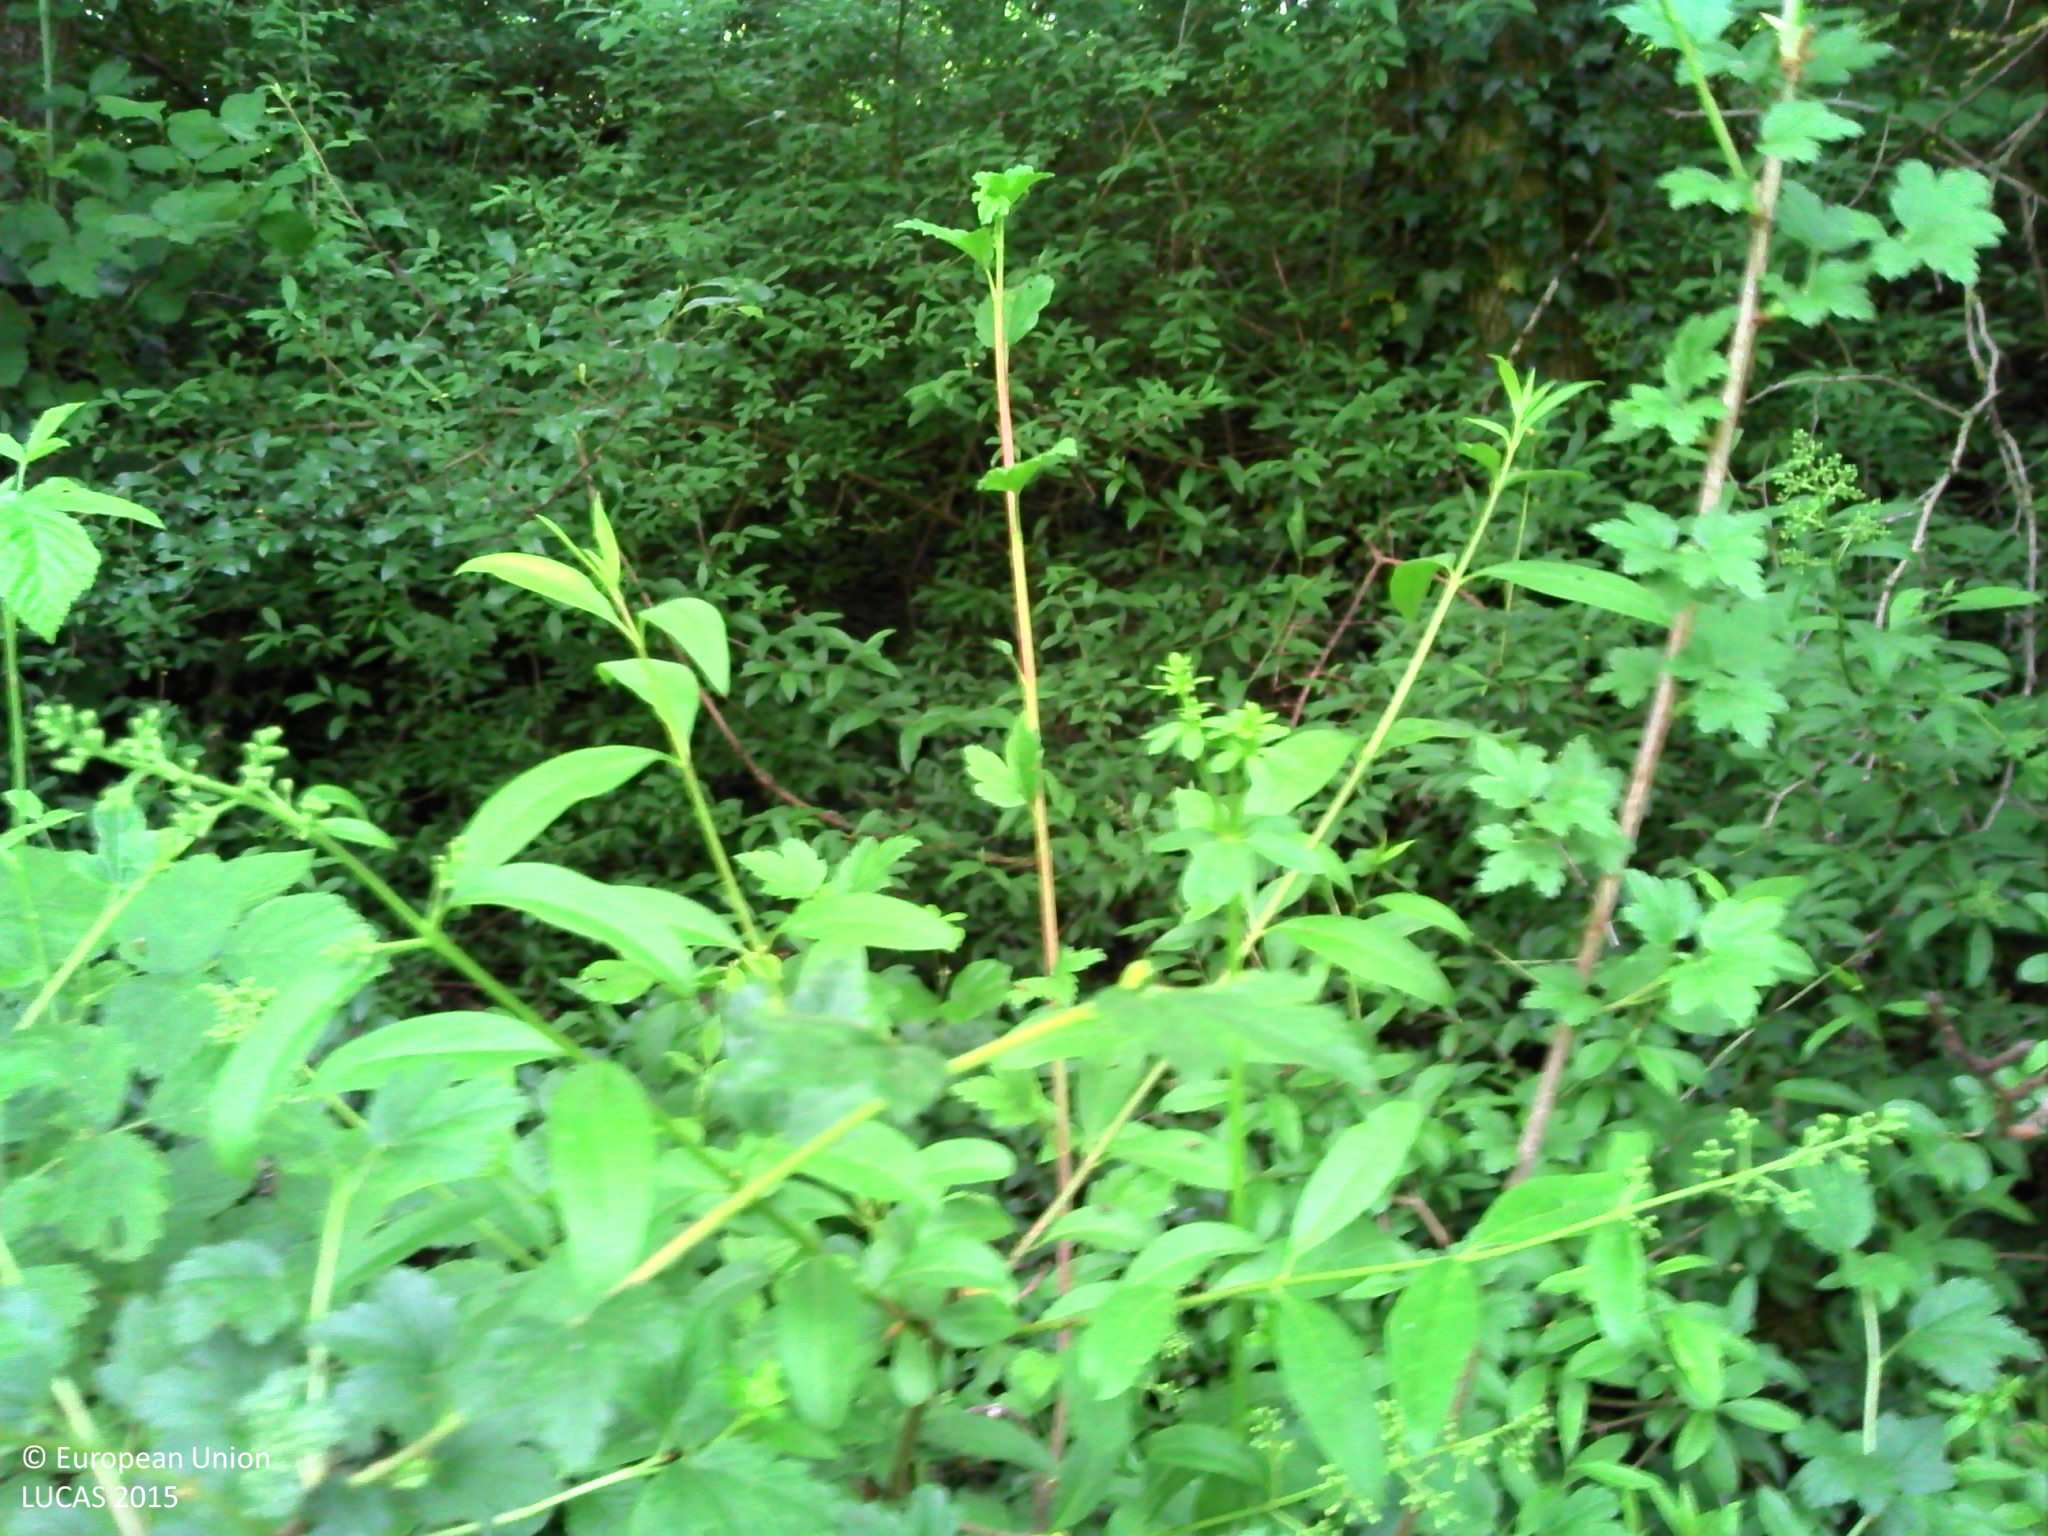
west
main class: Woodland
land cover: Broadleaved woodland
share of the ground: > 75 %
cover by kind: broadleaved forest trees 85 %, shrubs 10 %, lichens and mosses 5 %
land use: Forestry
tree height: > 5 m
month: May
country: FR
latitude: 44.3650
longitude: 2.9650
